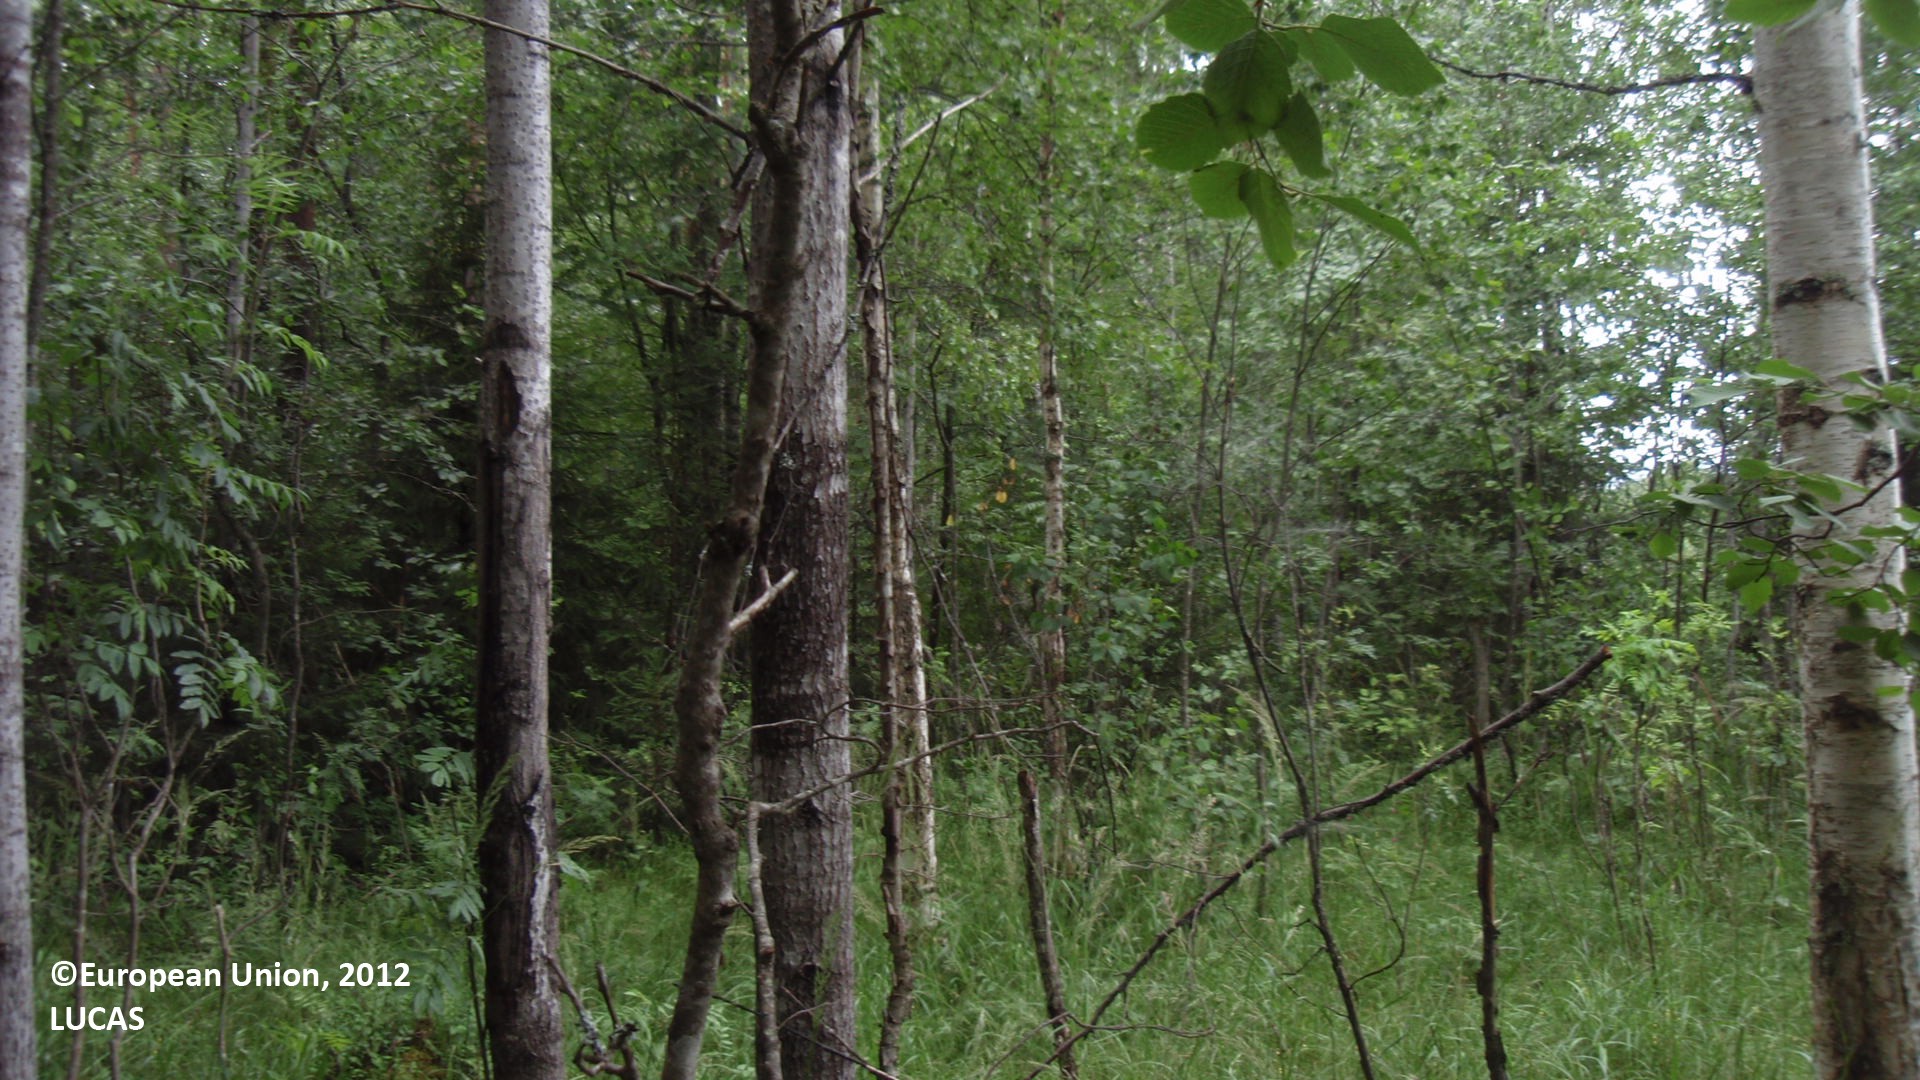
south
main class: Woodland
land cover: Broadleaved woodland
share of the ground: > 75 %
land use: Forestry
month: July
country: FI
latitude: 61.4809
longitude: 27.1973
